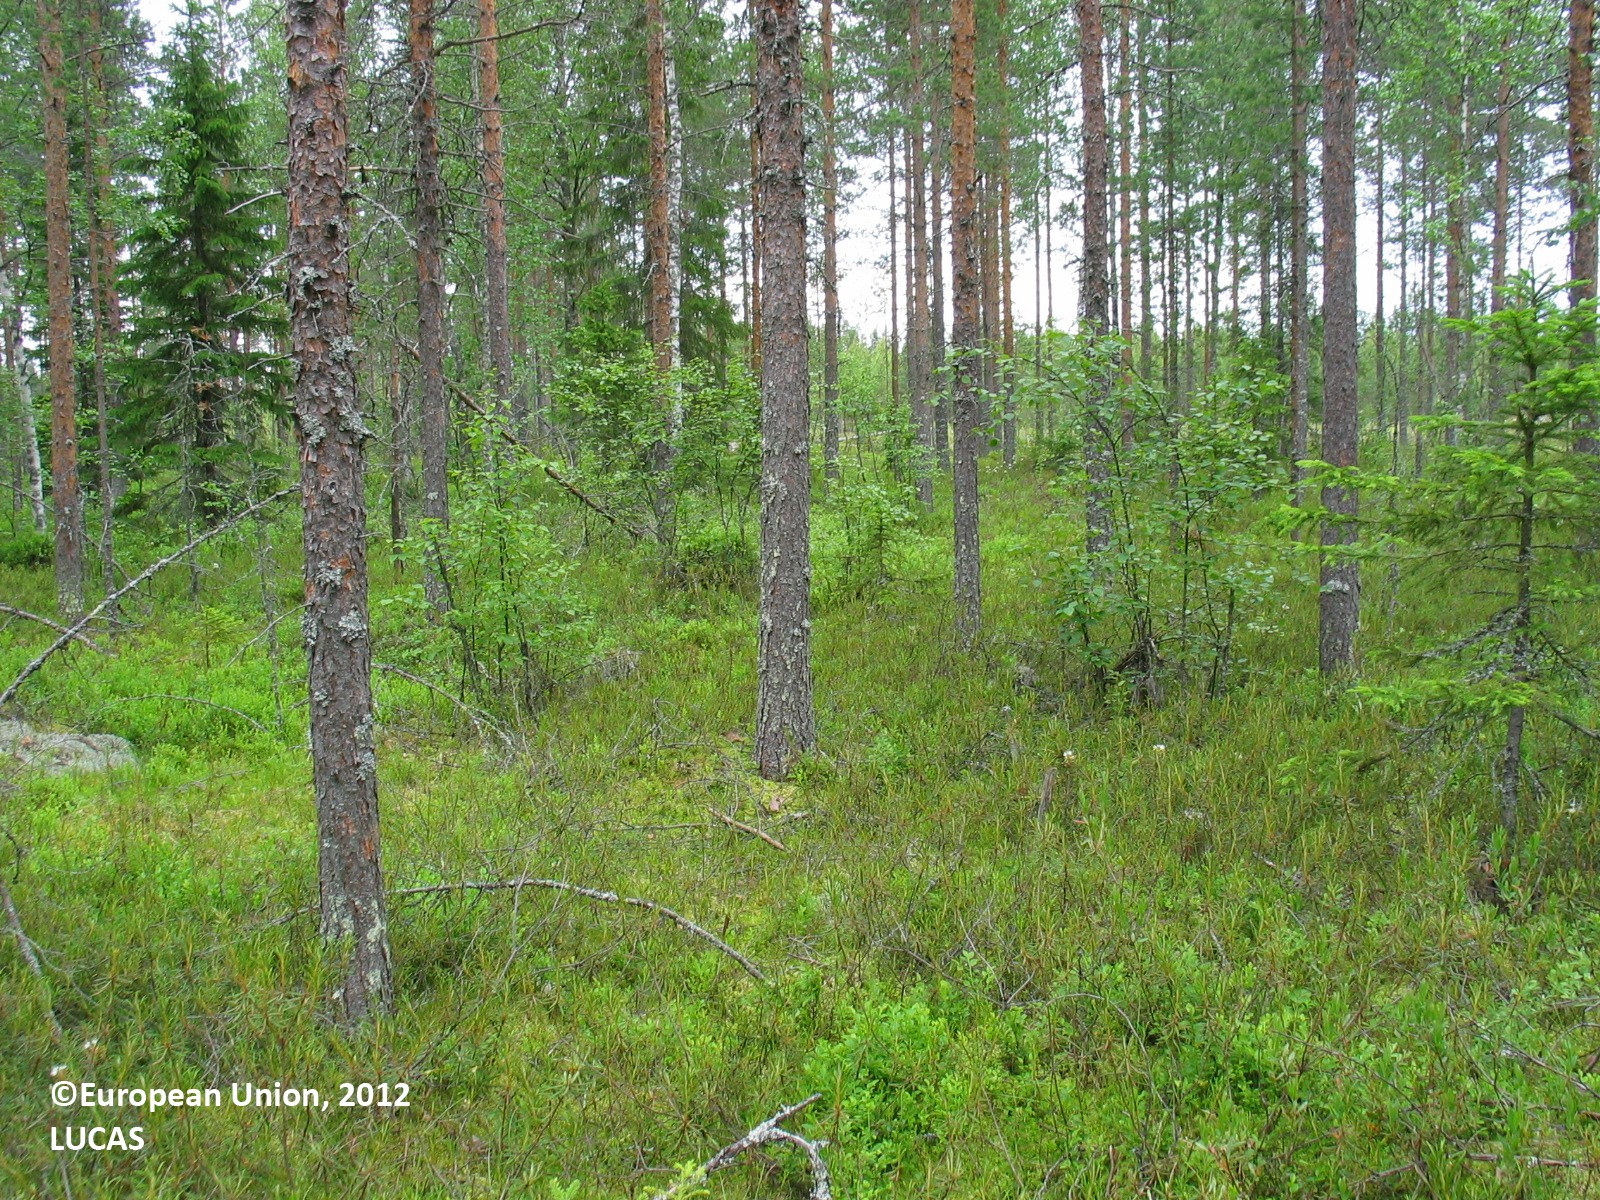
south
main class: Woodland
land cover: Pine dominated coniferous woodland
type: mire and swamp forests
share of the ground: 25 - 50 %
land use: Forestry
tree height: > 5 m
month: July
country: FI
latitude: 64.6474
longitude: 26.5879
